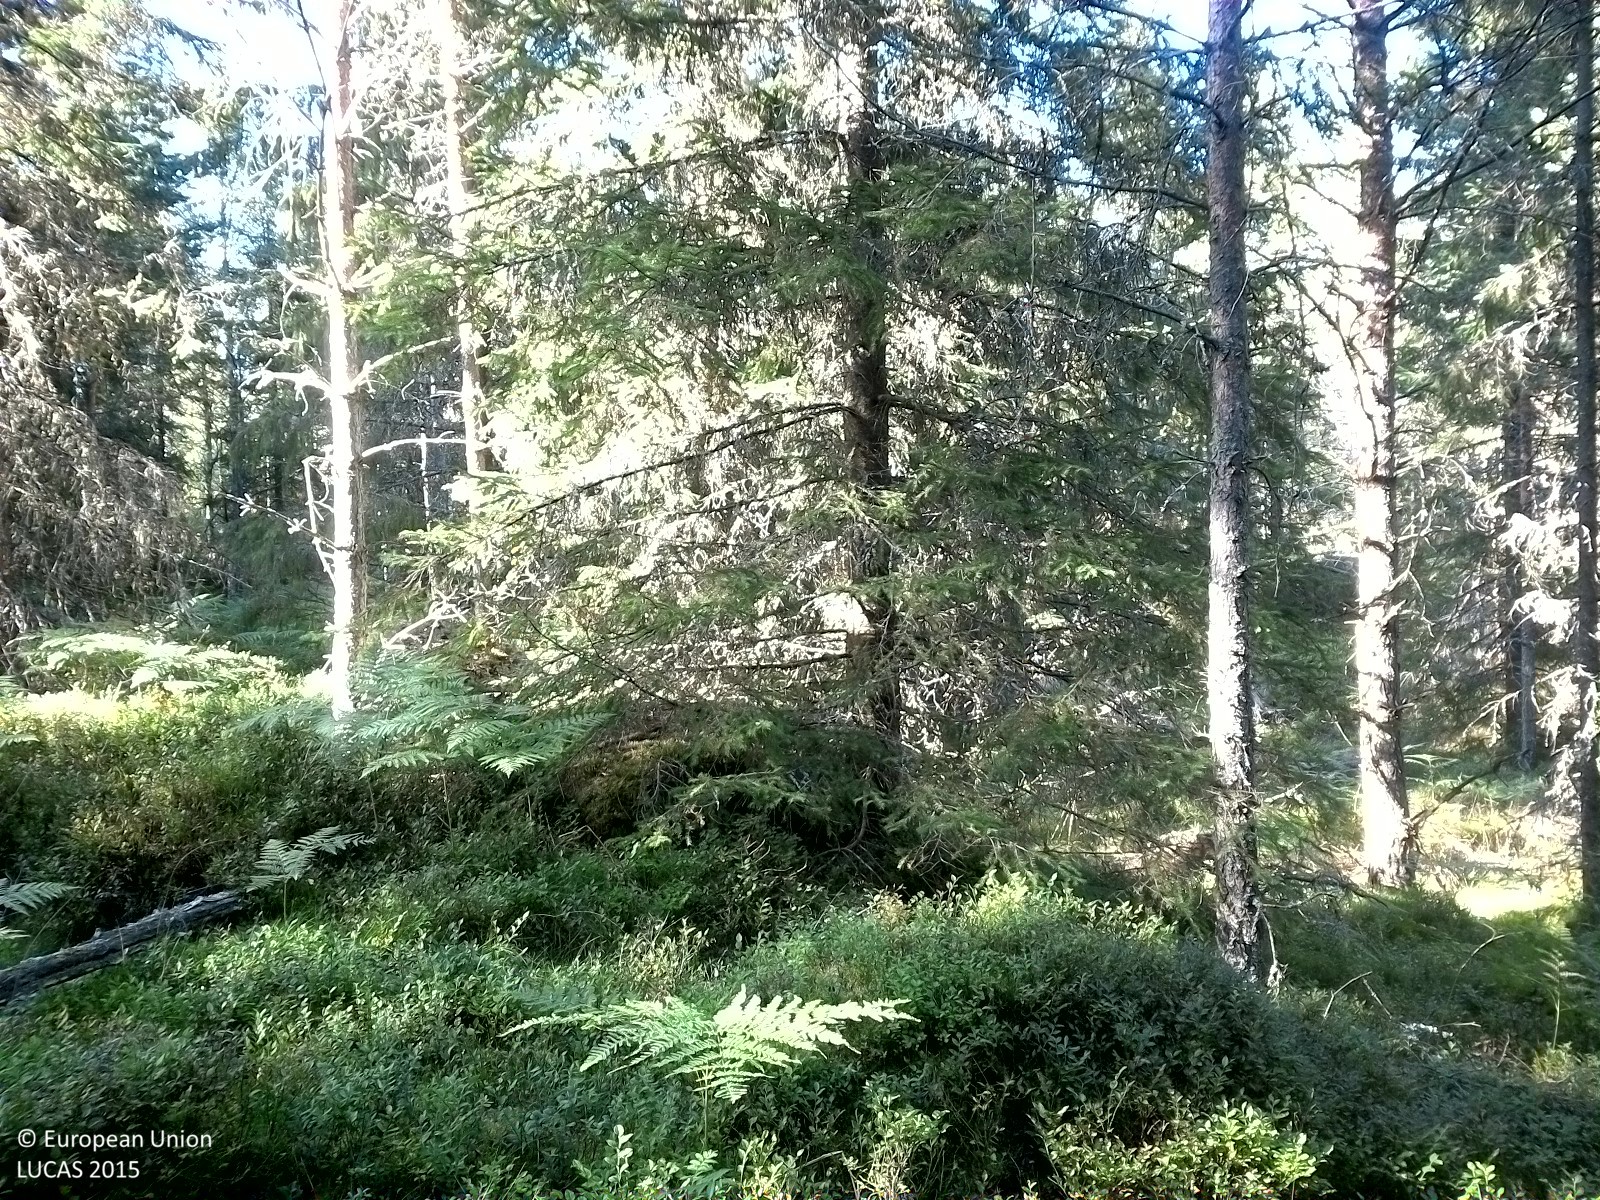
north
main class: Woodland
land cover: Other coniferous woodland
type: boreal forest
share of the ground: 25 - 50 %
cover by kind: herbaceous plants 45 %, coniferous forest trees 40 %, lichens and mosses 15 %
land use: Forestry
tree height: > 5 m
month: August
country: SE
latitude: 59.2199
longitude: 14.6693
